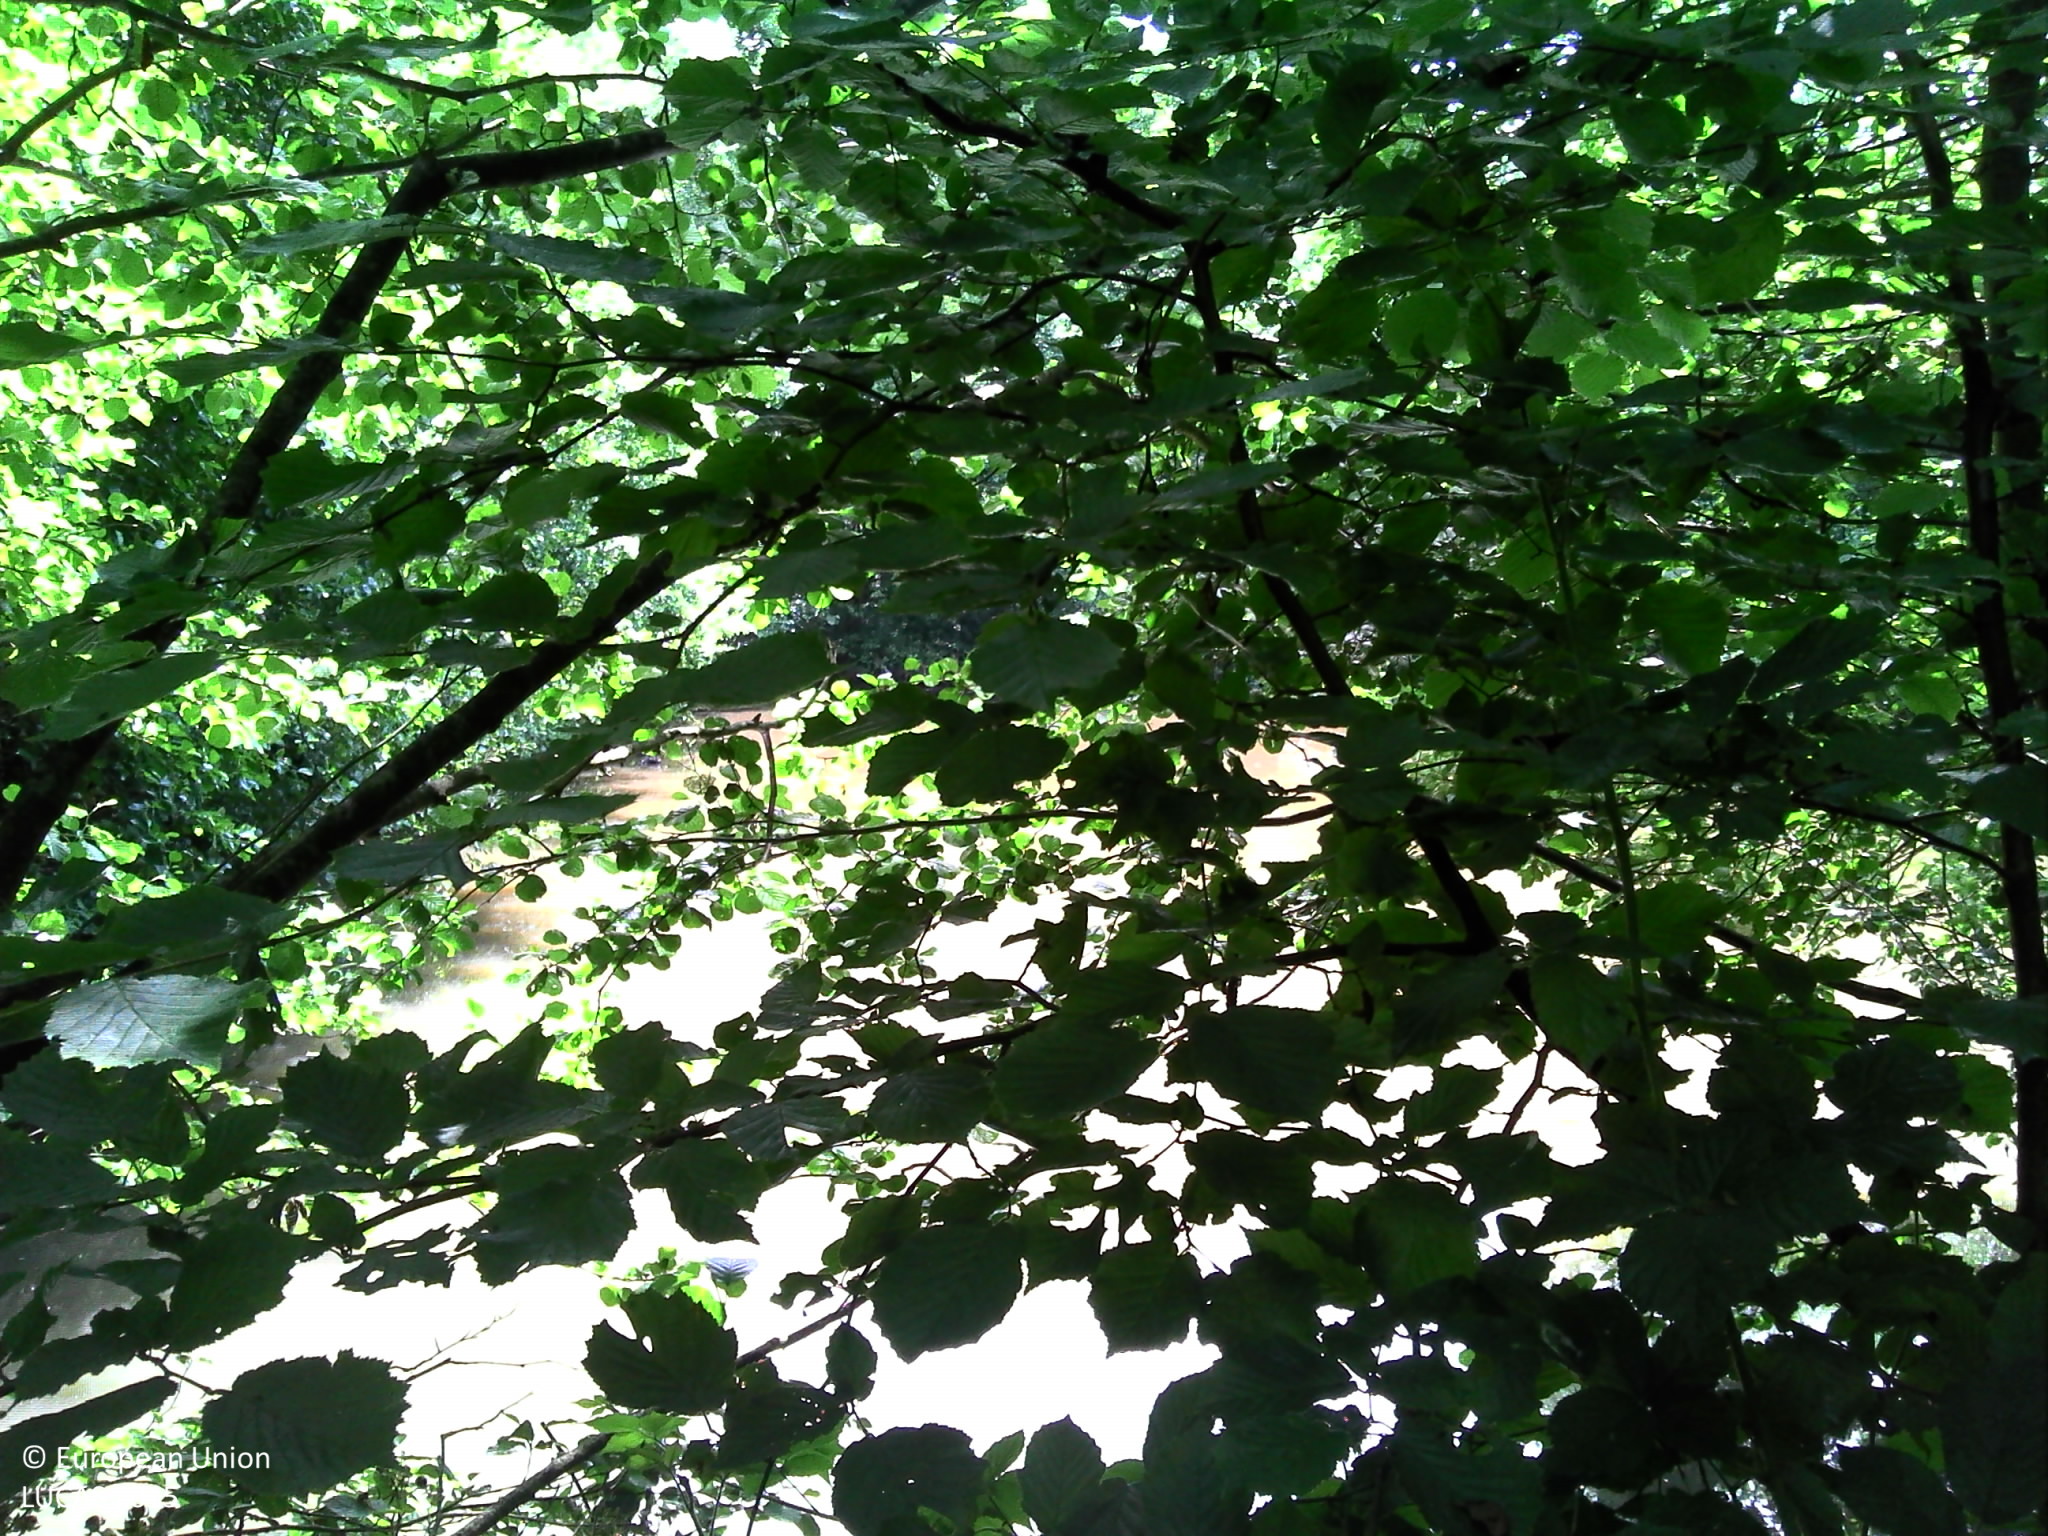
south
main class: Woodland
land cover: Broadleaved woodland
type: floodplain forest
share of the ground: > 75 %
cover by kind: broadleaved forest trees 95 %, herbaceous plants 5 %
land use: Forestry
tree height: > 5 m
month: July
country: BE
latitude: 50.2750
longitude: 4.6503
